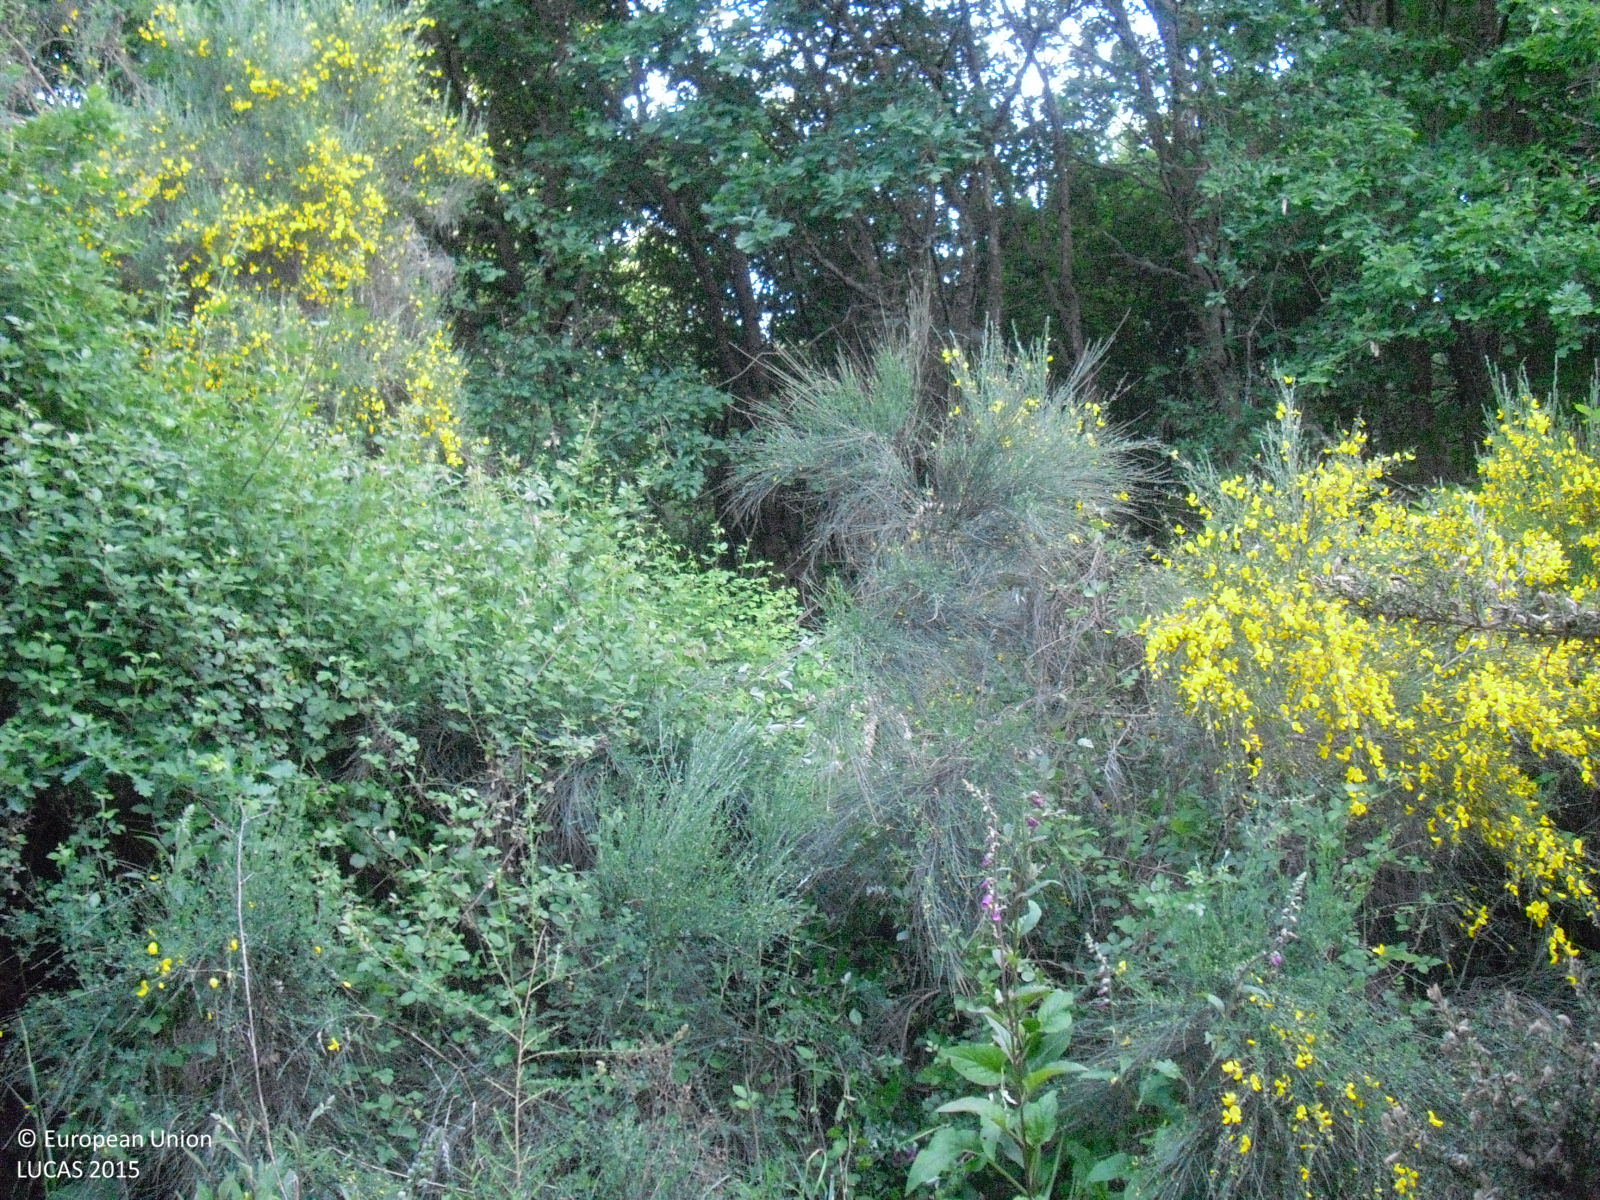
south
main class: Shrubland
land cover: Shrubland with sparse tree cover
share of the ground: > 75 %
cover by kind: shrubs 80 %, herbaceous plants 15 %, broadleaved forest trees 5 %
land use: Abandoned areas
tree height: < 5 m
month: May
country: ES
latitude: 42.2290
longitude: -7.7751
